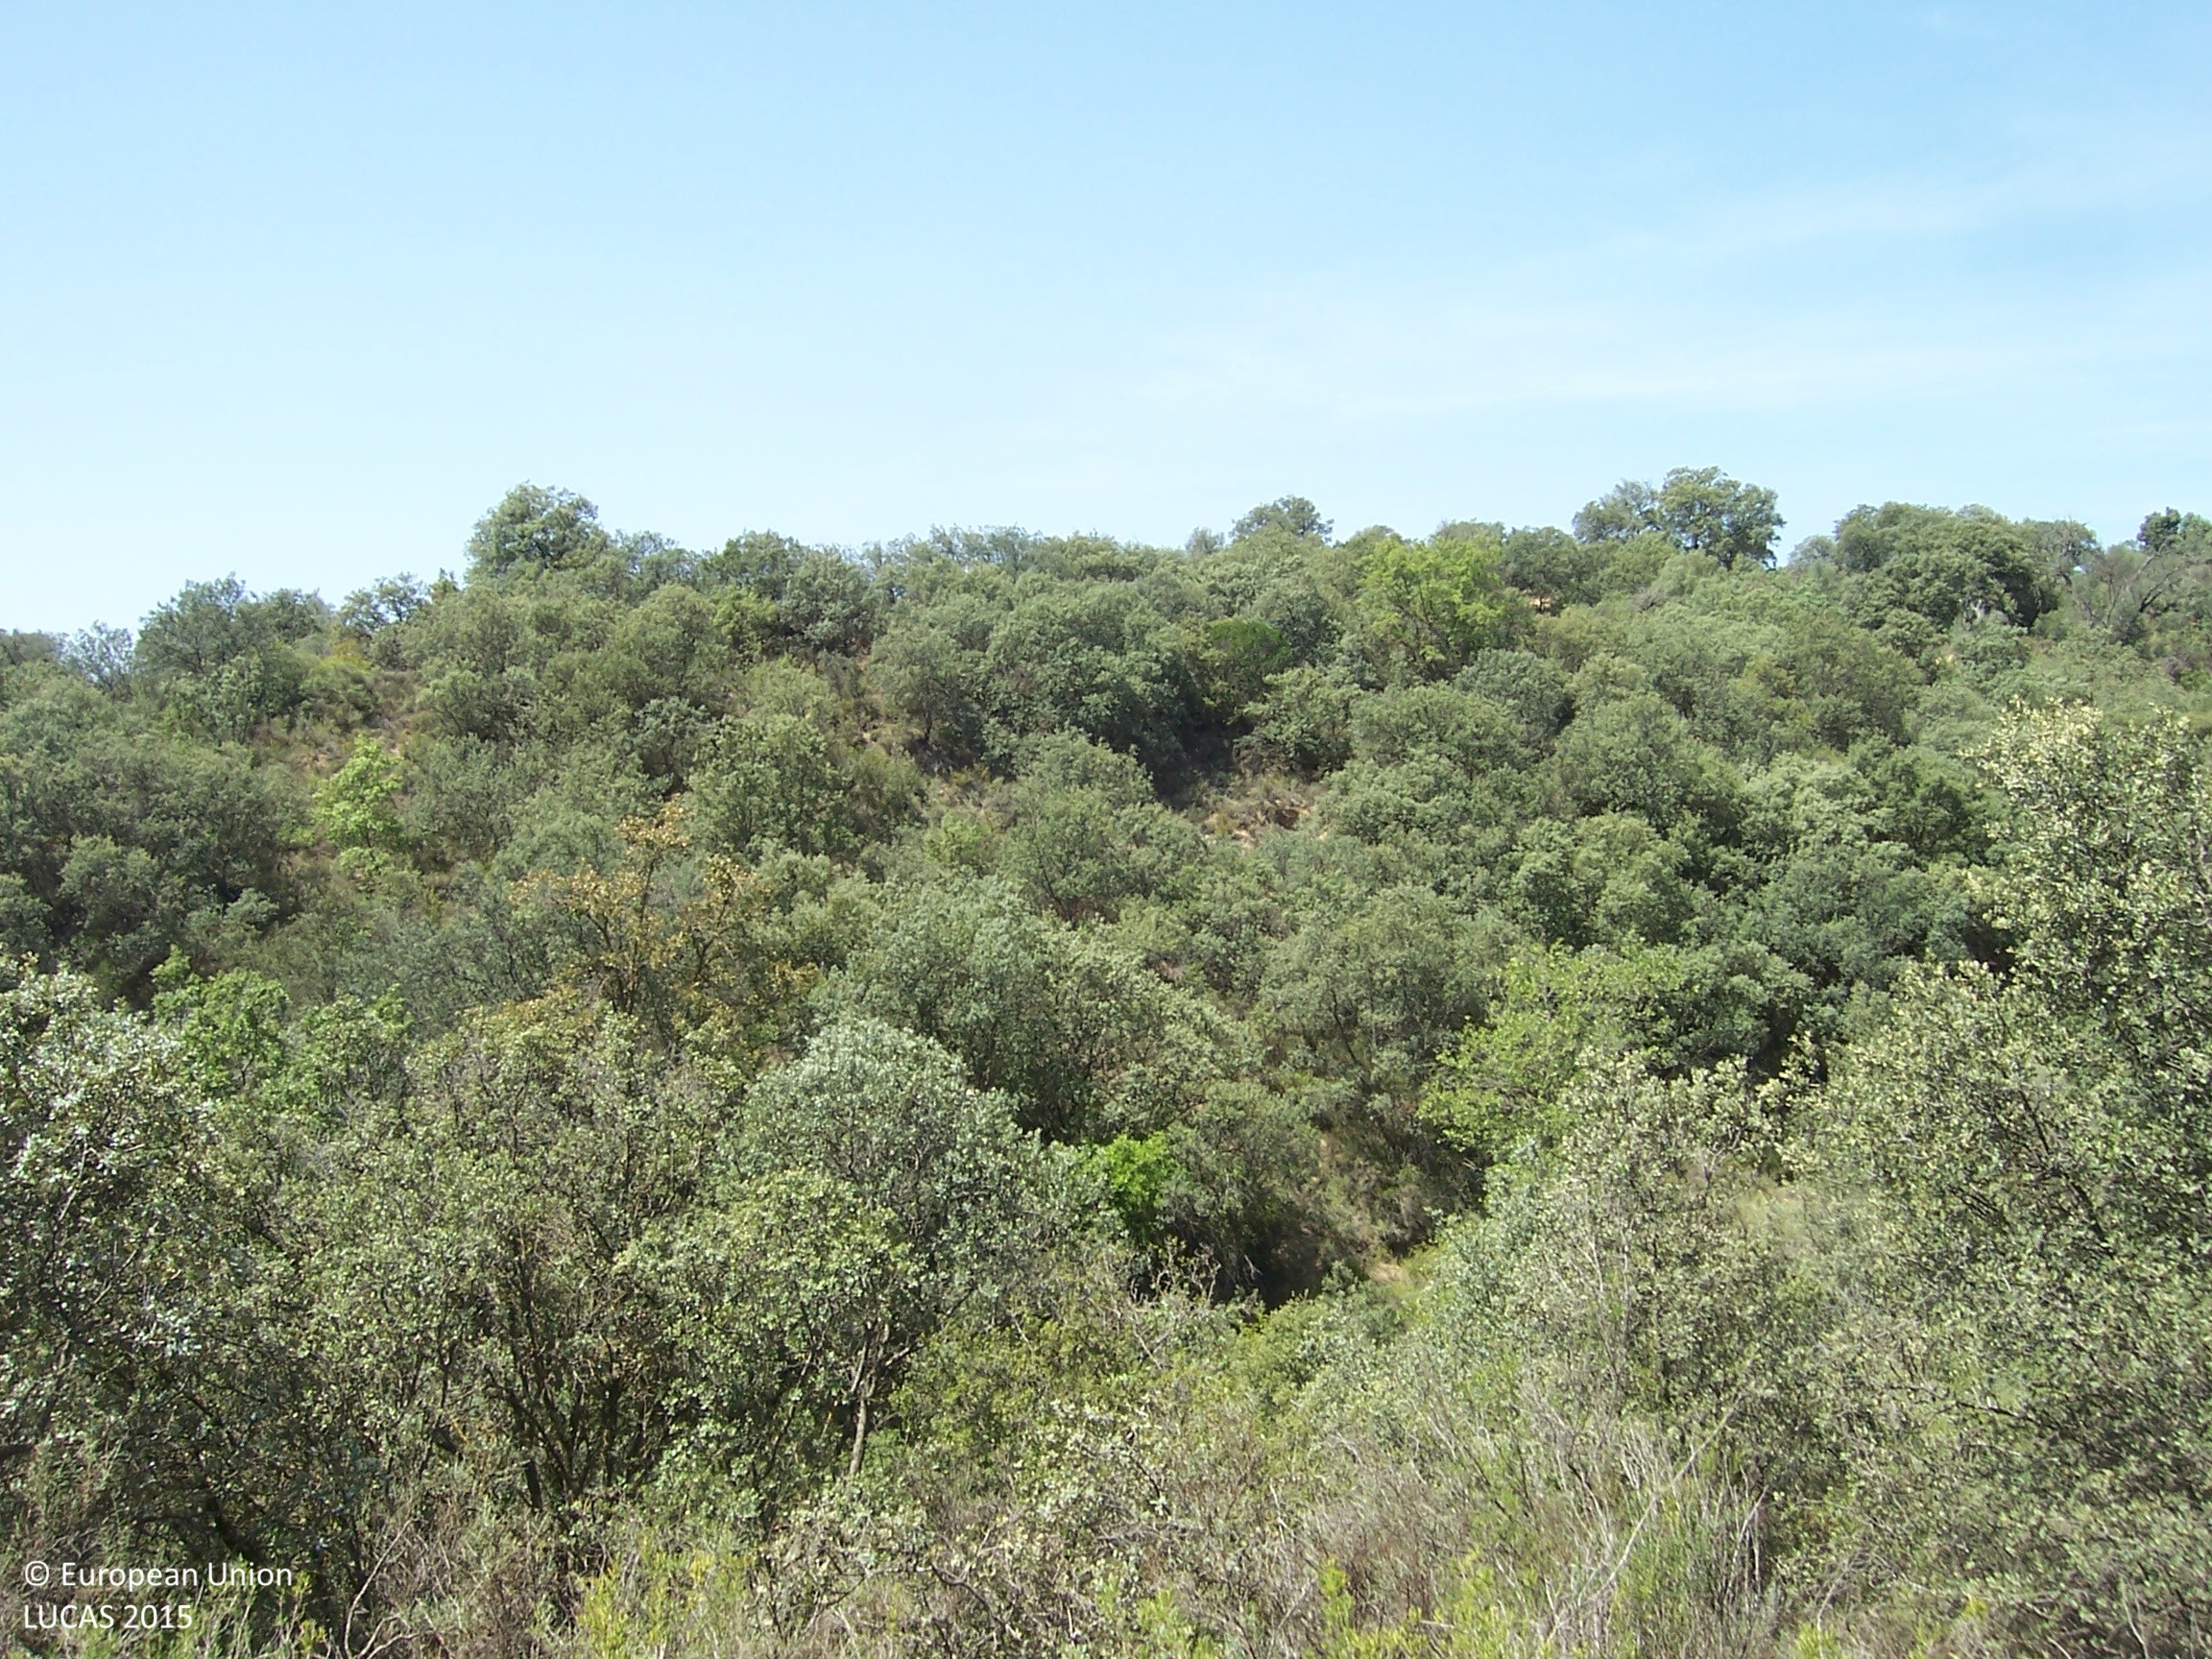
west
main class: Woodland
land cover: Broadleaved woodland
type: broadleaved evergreen forest
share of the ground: > 75 %
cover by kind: broadleaved forest trees 50 %, herbaceous plants 30 %, shrubs 10 %, unconsolidated bare surface 10 %
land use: Semi-natural and natural areas not in use
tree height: > 5 m
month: August
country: ES
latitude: 42.1383
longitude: 0.1689
